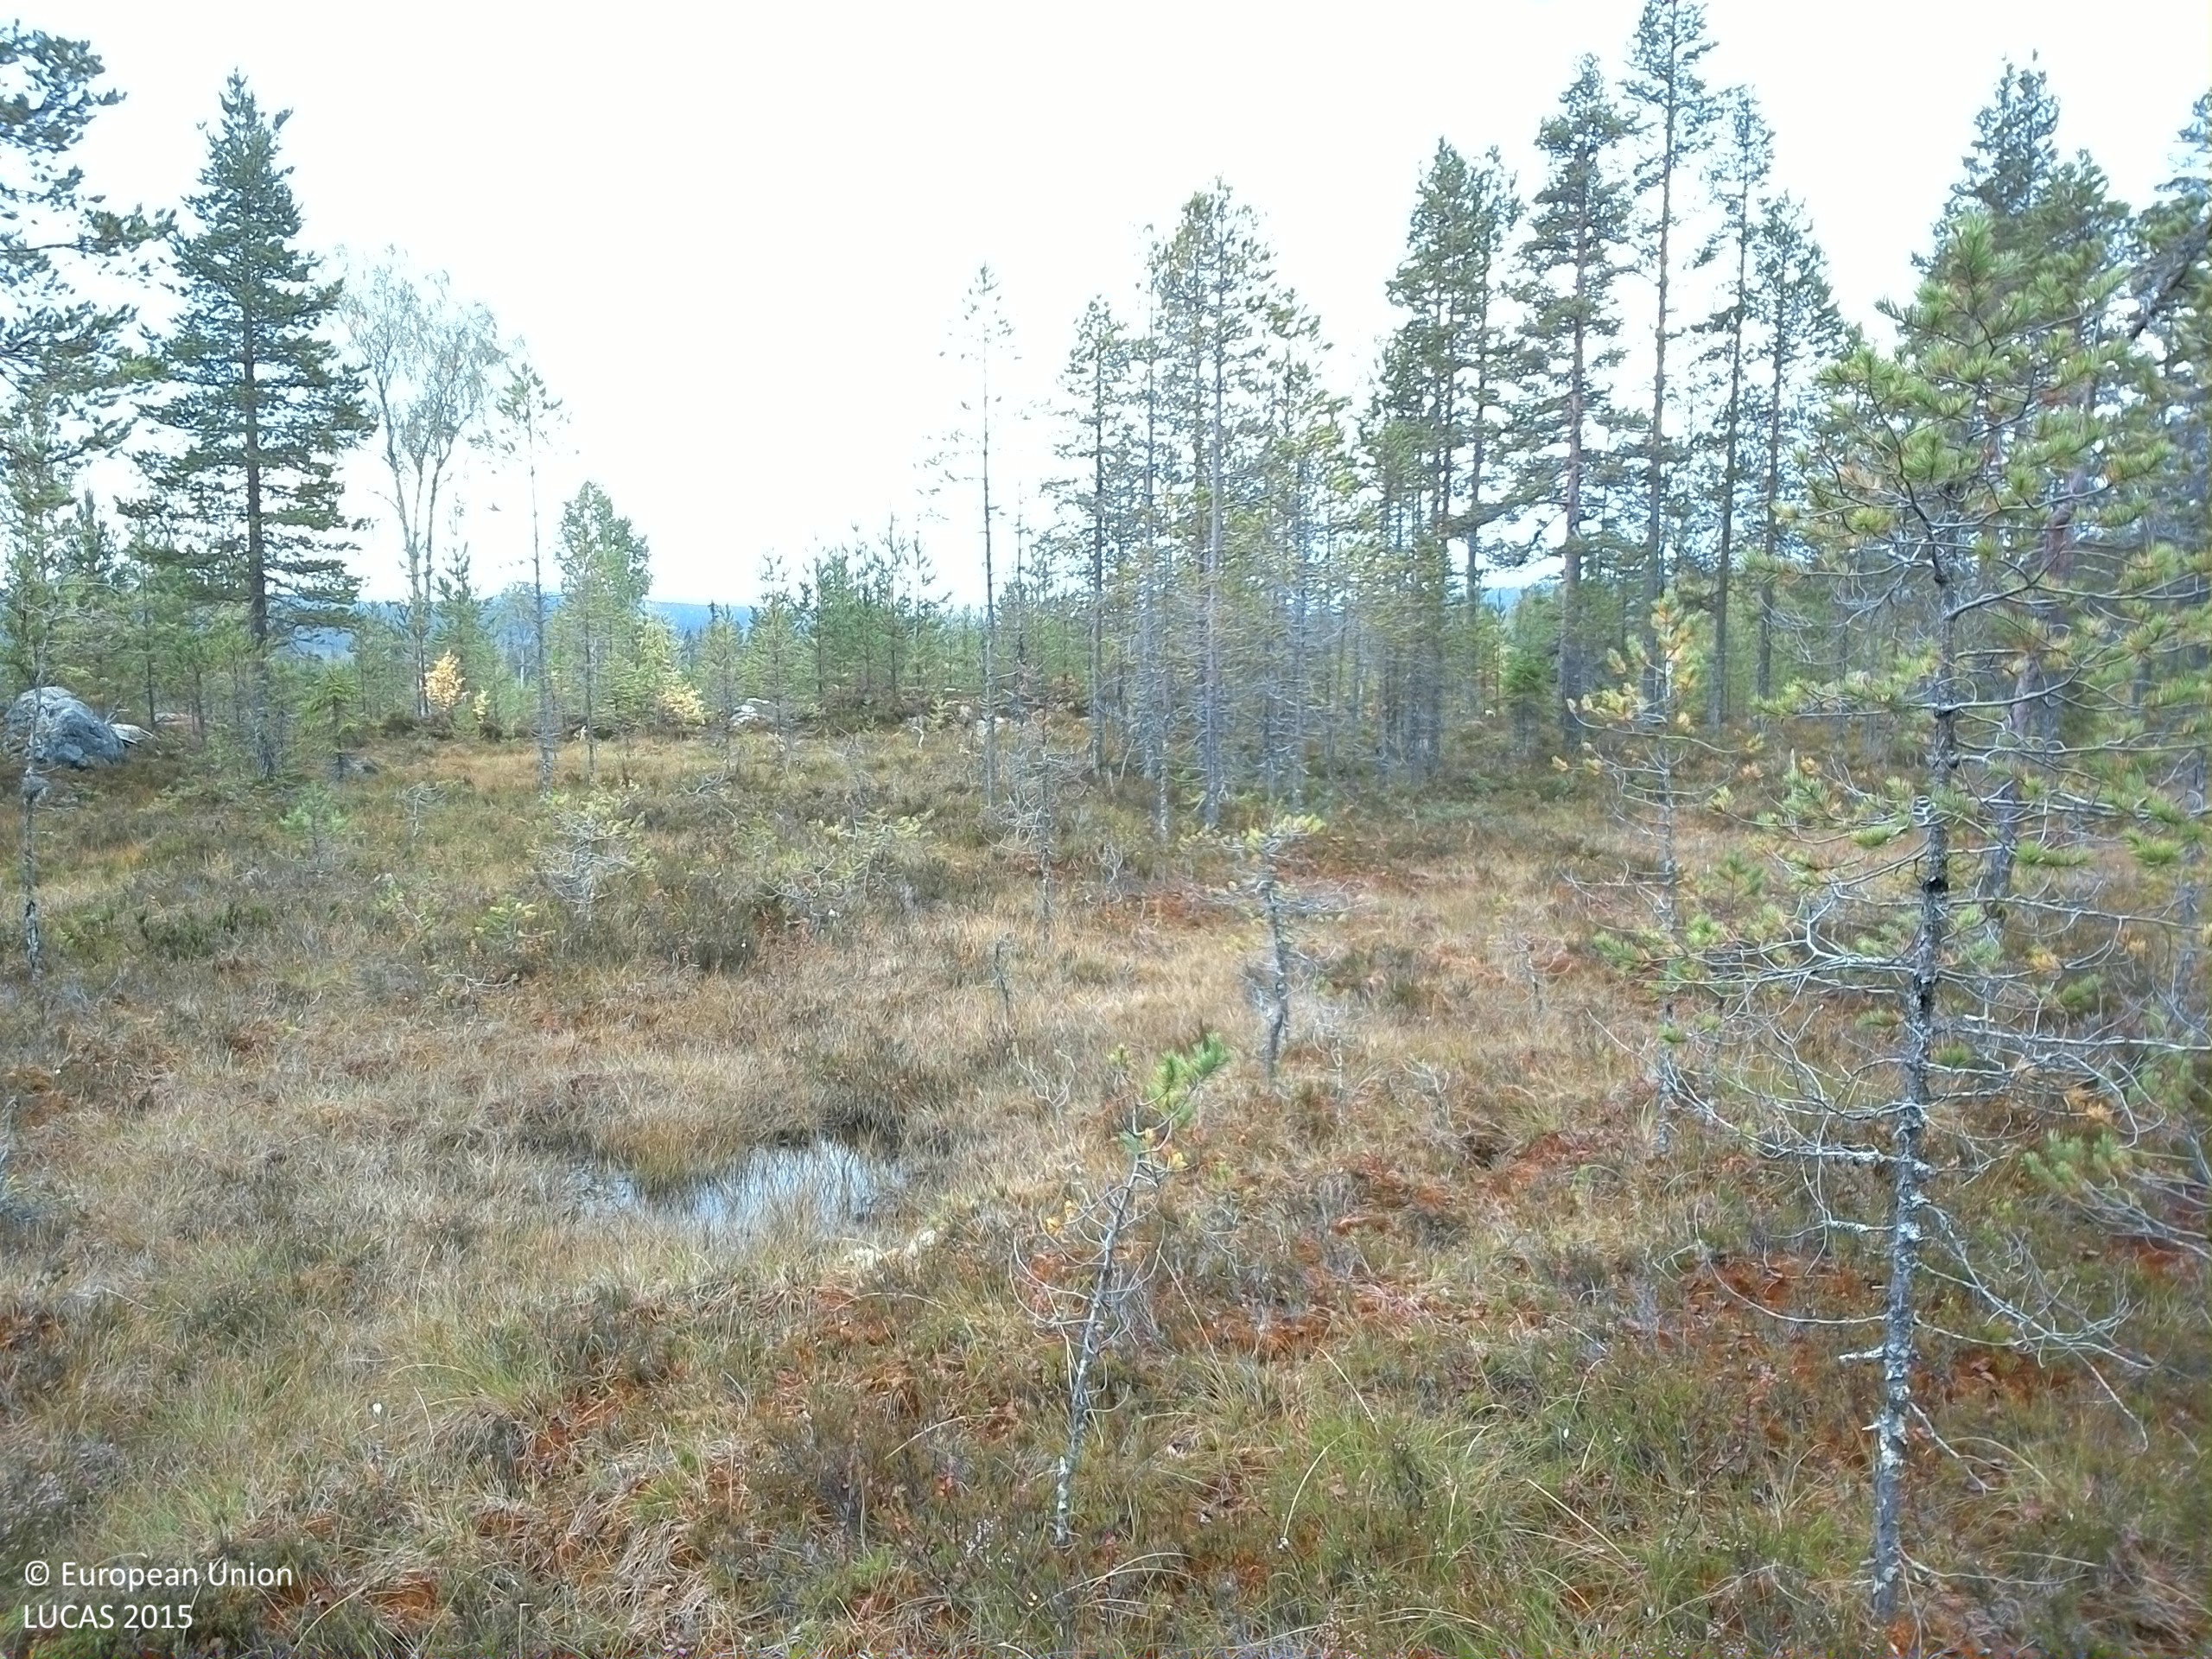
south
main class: Woodland
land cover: Pine dominated coniferous woodland
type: mire and swamp forests
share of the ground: 10 - 25 %
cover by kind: shrubs 40 %, lichens and mosses 40 %, coniferous forest trees 20 %
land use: Semi-natural and natural areas not in use
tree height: < 5 m
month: September
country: SE
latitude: 61.5344
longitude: 15.0434
